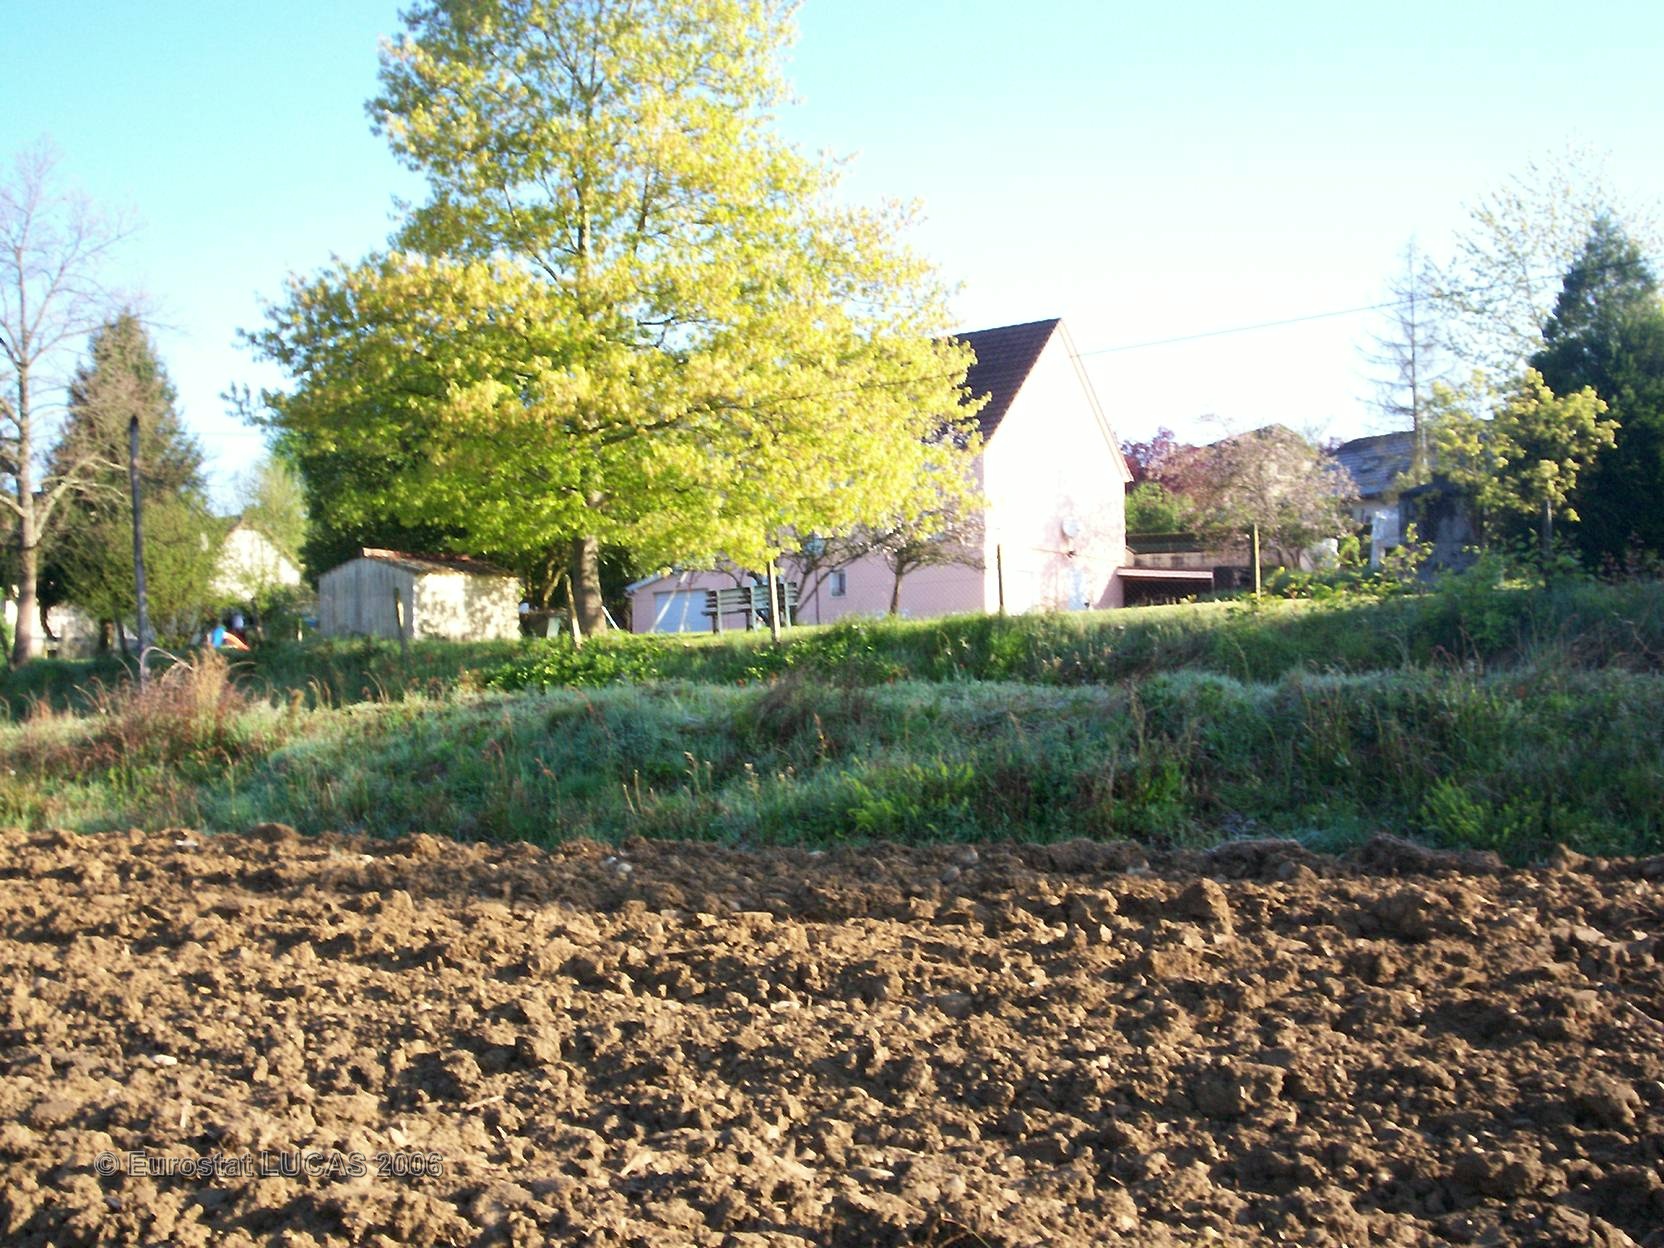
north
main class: Cropland
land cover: Maize
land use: Agriculture (excluding fallow land and kitchen gardens)
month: June
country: FR
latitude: 43.3631
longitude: -0.3103
